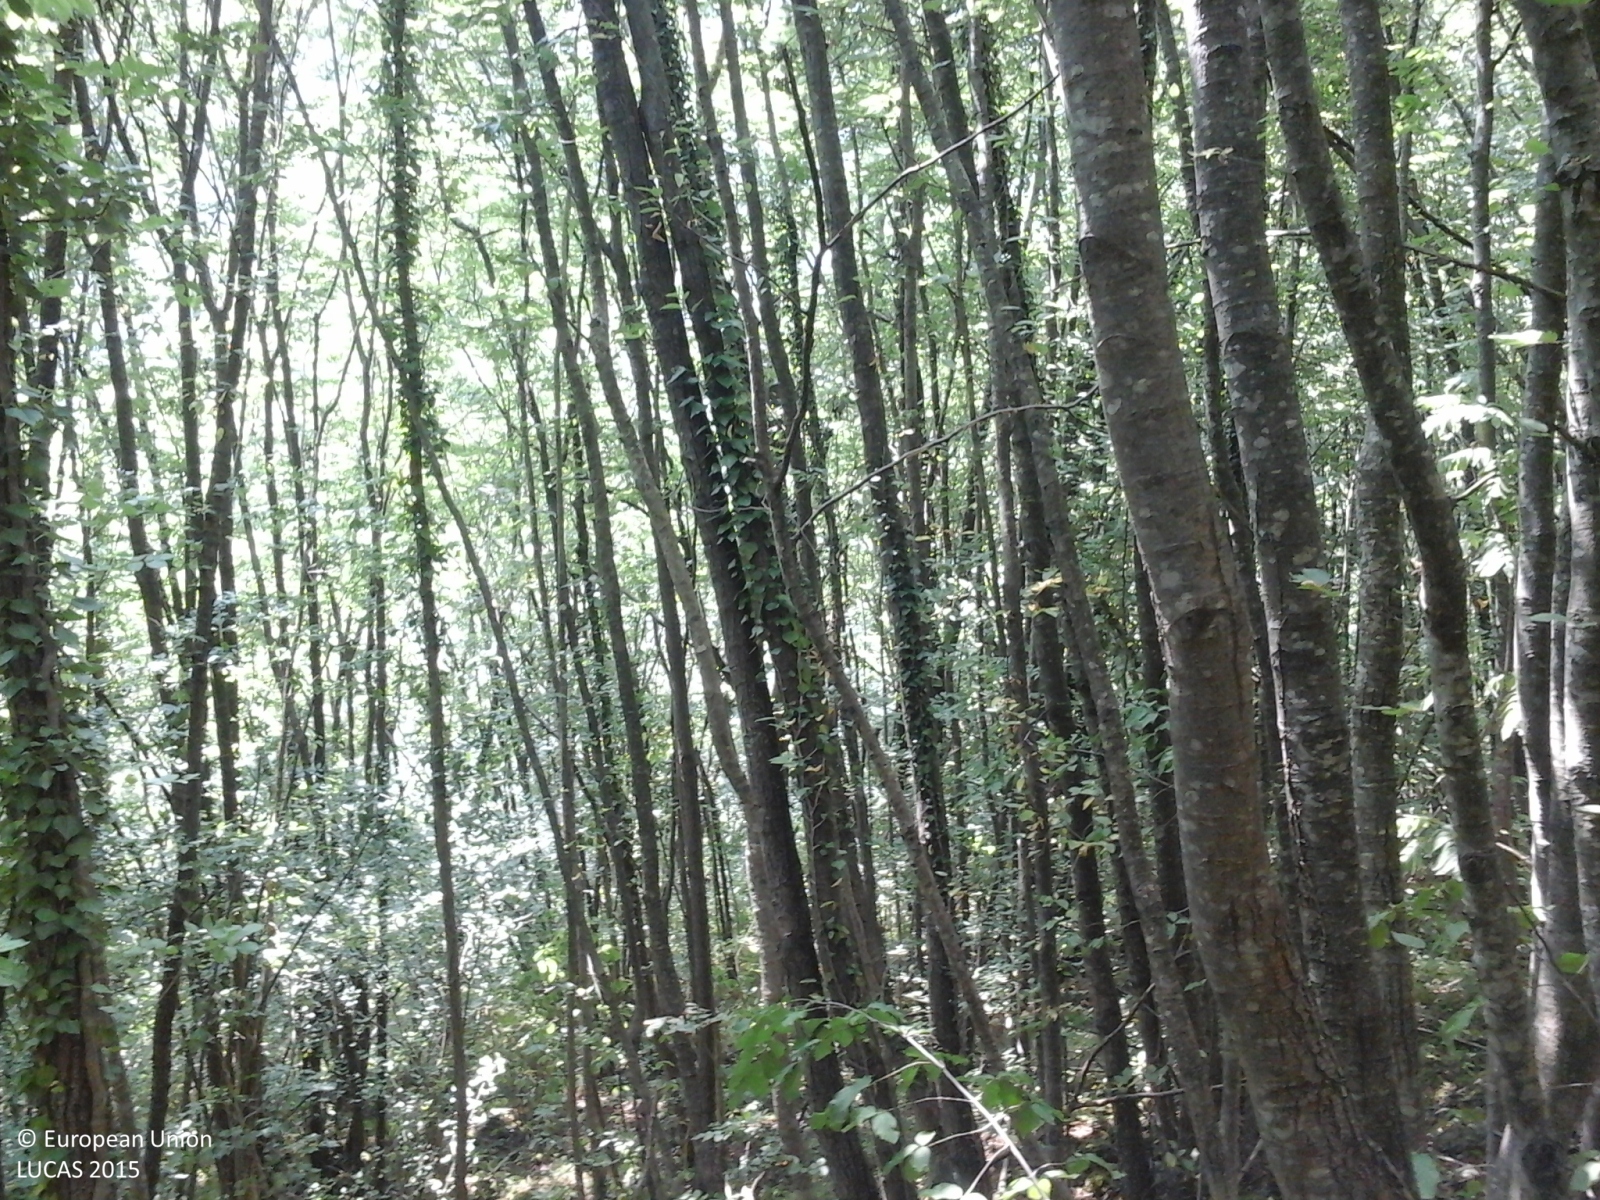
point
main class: Woodland
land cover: Broadleaved woodland
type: mountainous beech forest
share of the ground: > 75 %
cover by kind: broadleaved forest trees 100 %
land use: Forestry
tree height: > 5 m
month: July
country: IT
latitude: 45.6252
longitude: 11.0628
